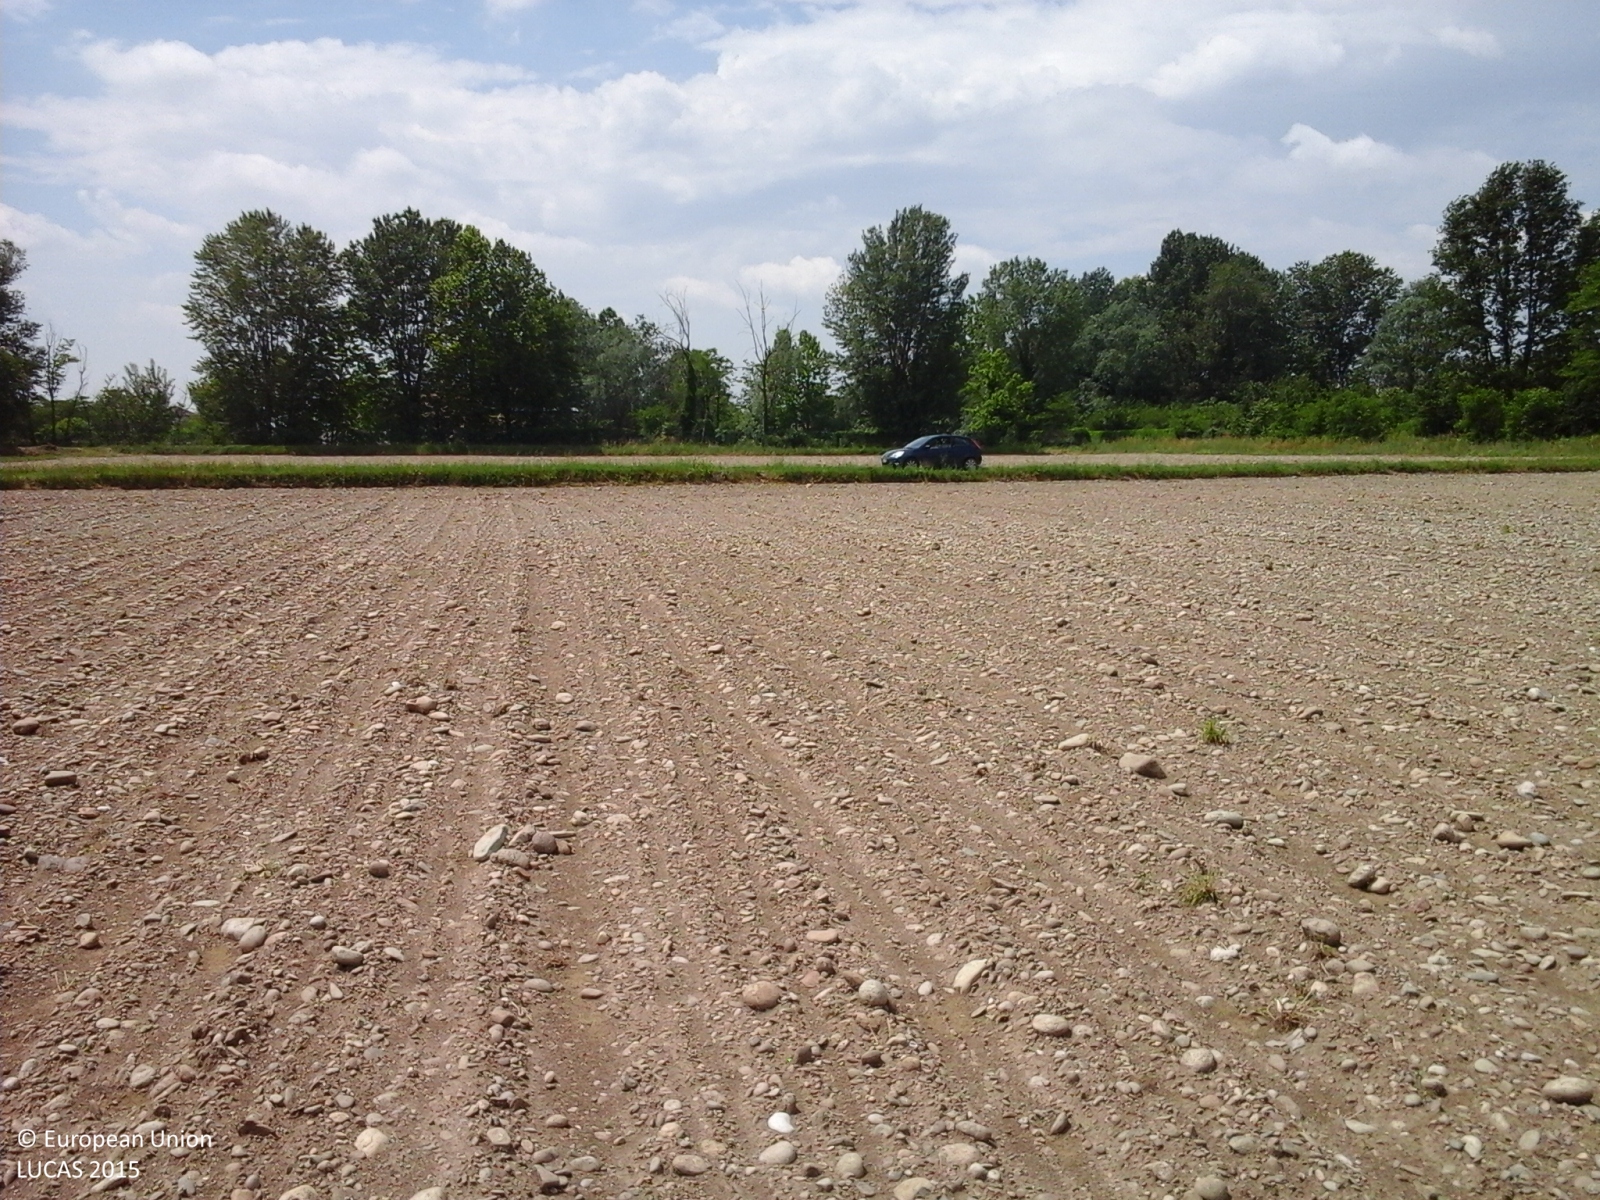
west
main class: Cropland
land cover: Maize
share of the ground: < 10 %
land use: Agriculture (excluding fallow land and kitchen gardens)
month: May
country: IT
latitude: 45.4674
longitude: 9.5531
